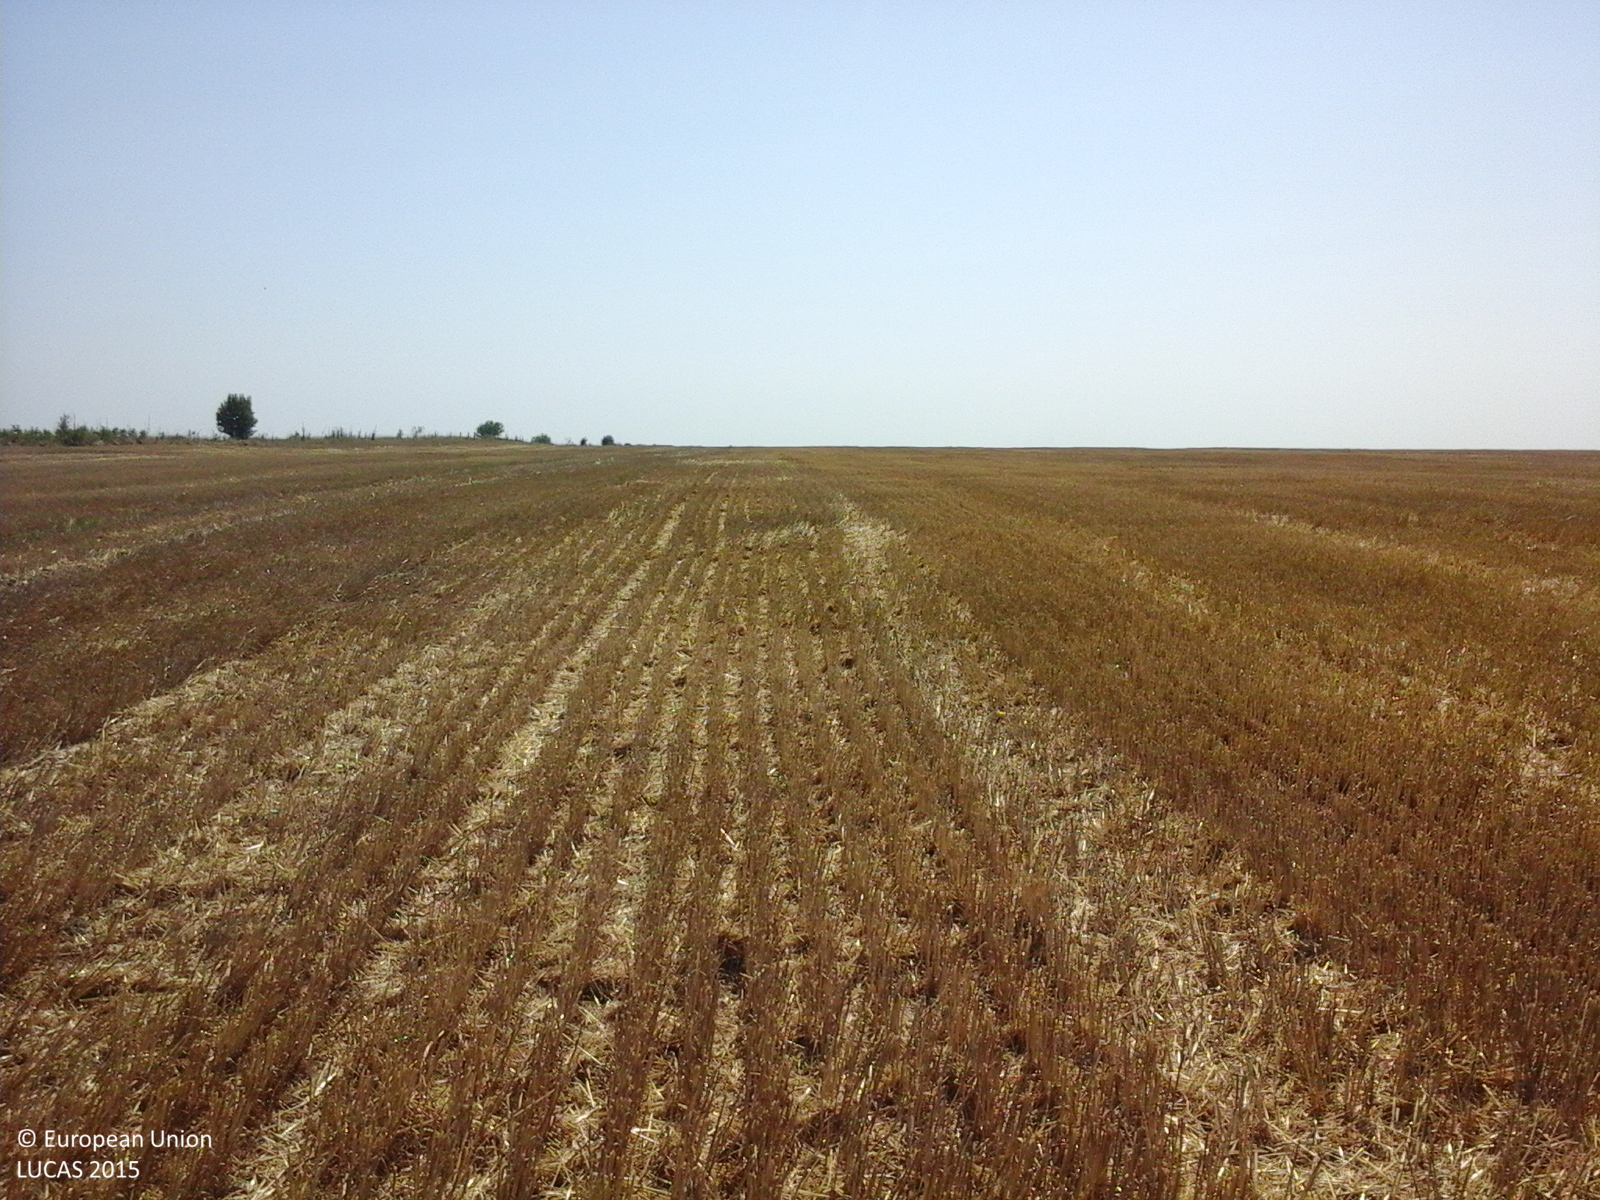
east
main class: Cropland
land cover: Durum wheat
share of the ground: > 75 %
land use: Agriculture (excluding fallow land and kitchen gardens)
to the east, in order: Durum wheat
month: July
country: RO
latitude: 44.2868
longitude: 27.4964
